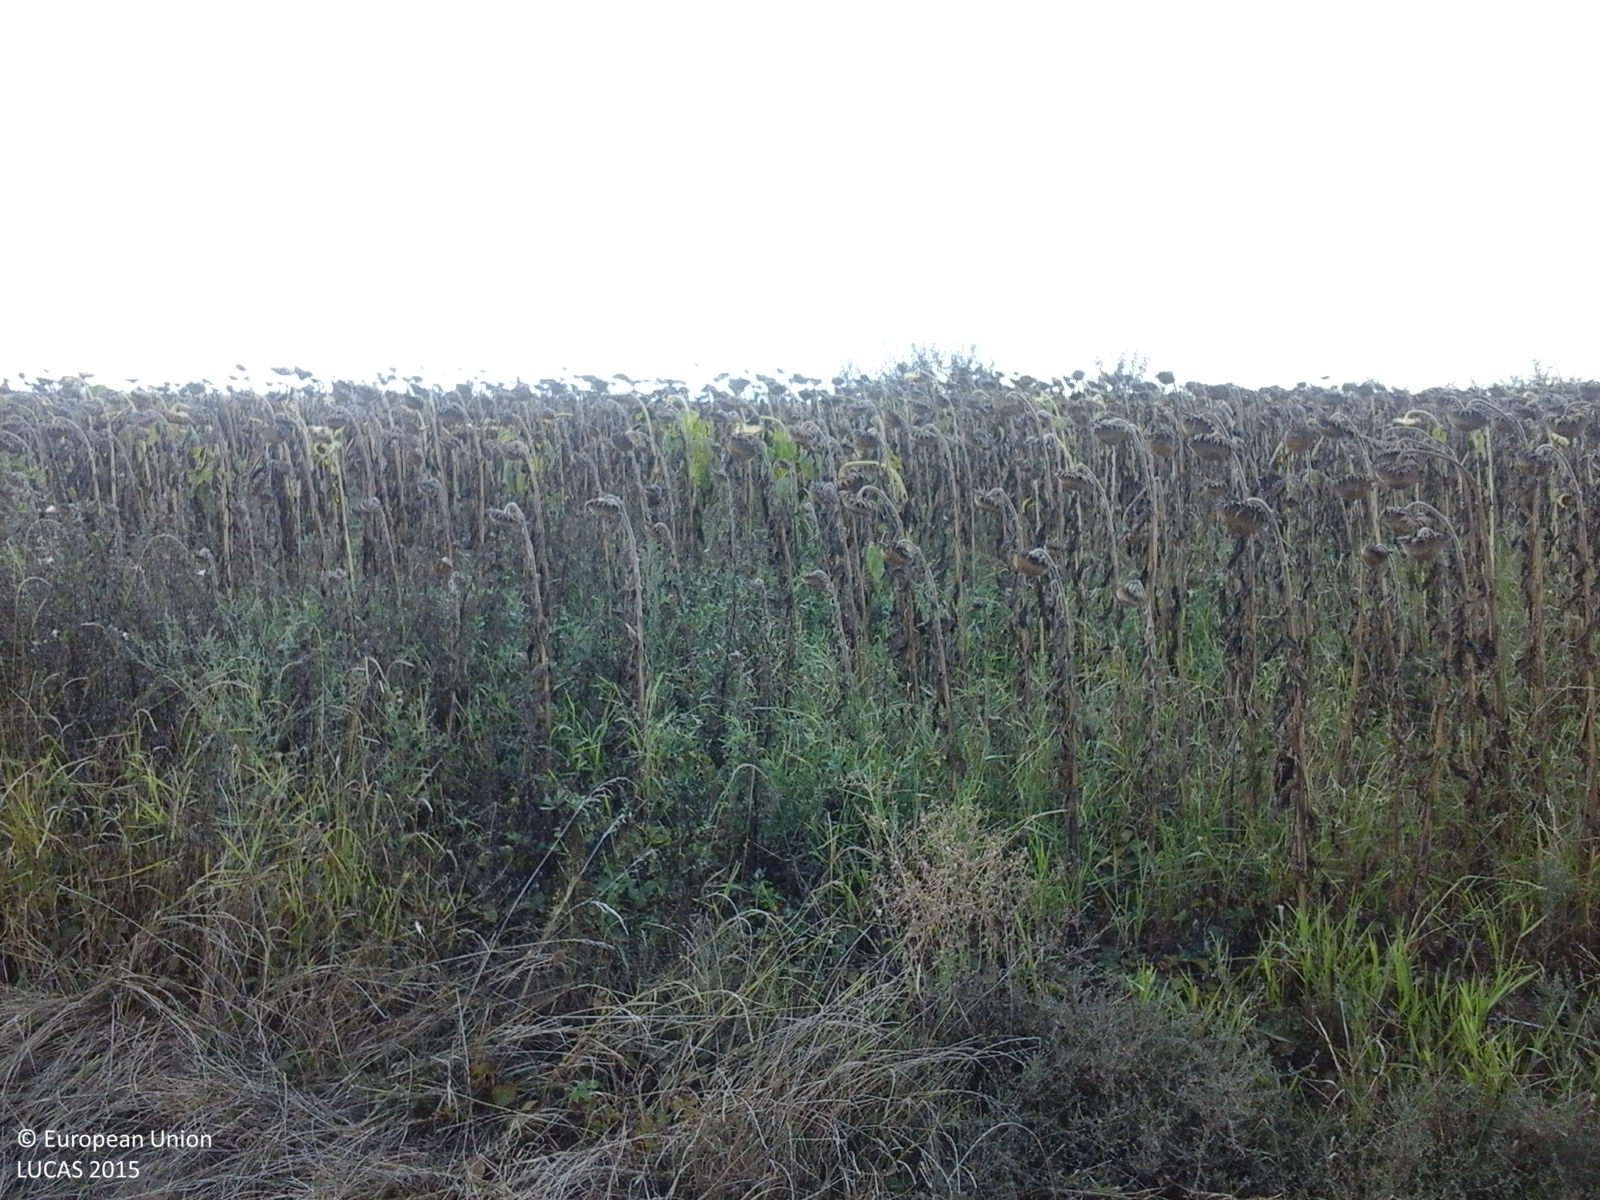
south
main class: Cropland
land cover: Maize
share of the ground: > 75 %
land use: Agriculture (excluding fallow land and kitchen gardens)
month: September
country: RO
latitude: 47.5823
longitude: 22.6511
